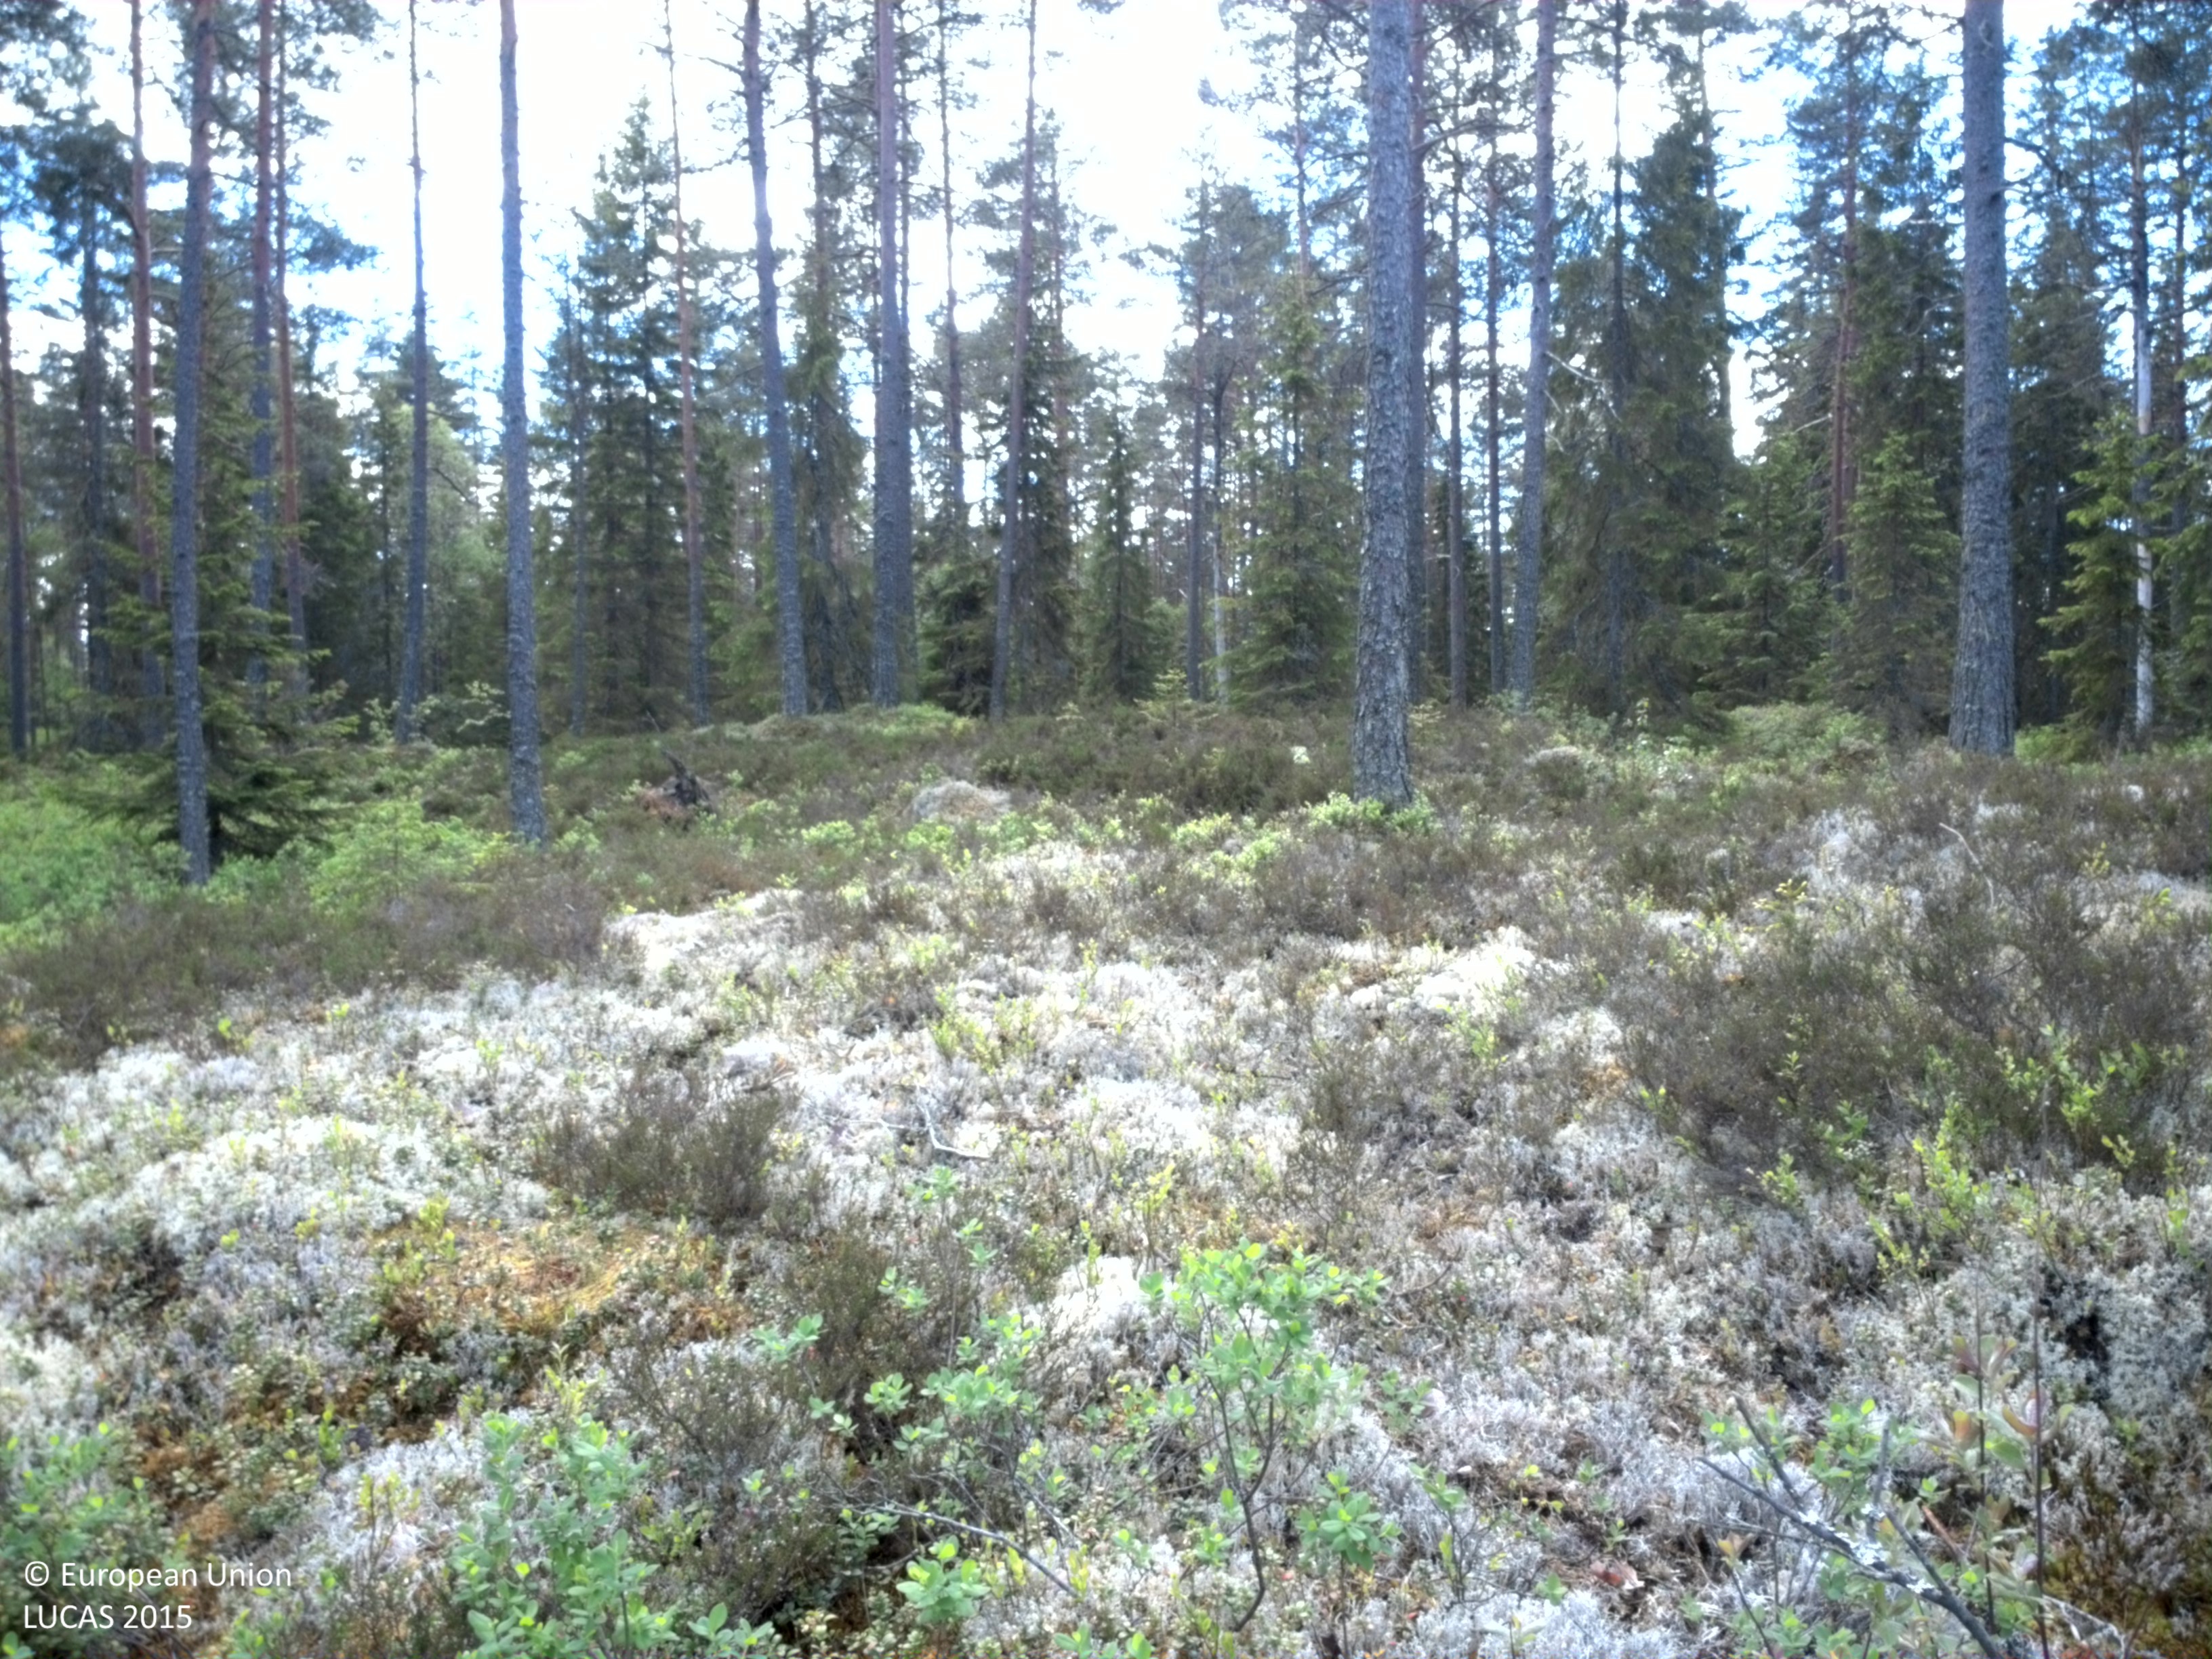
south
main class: Woodland
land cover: Pine dominated mixed woodland
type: boreal forest
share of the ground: 50 - 75 %
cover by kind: coniferous forest trees 35 %, broadleaved forest trees 25 %, shrubs 20 %, herbaceous plants 10 %, lichens and mosses 10 %
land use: Forestry
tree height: > 5 m
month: June
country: SE
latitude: 59.5163
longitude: 12.1328
